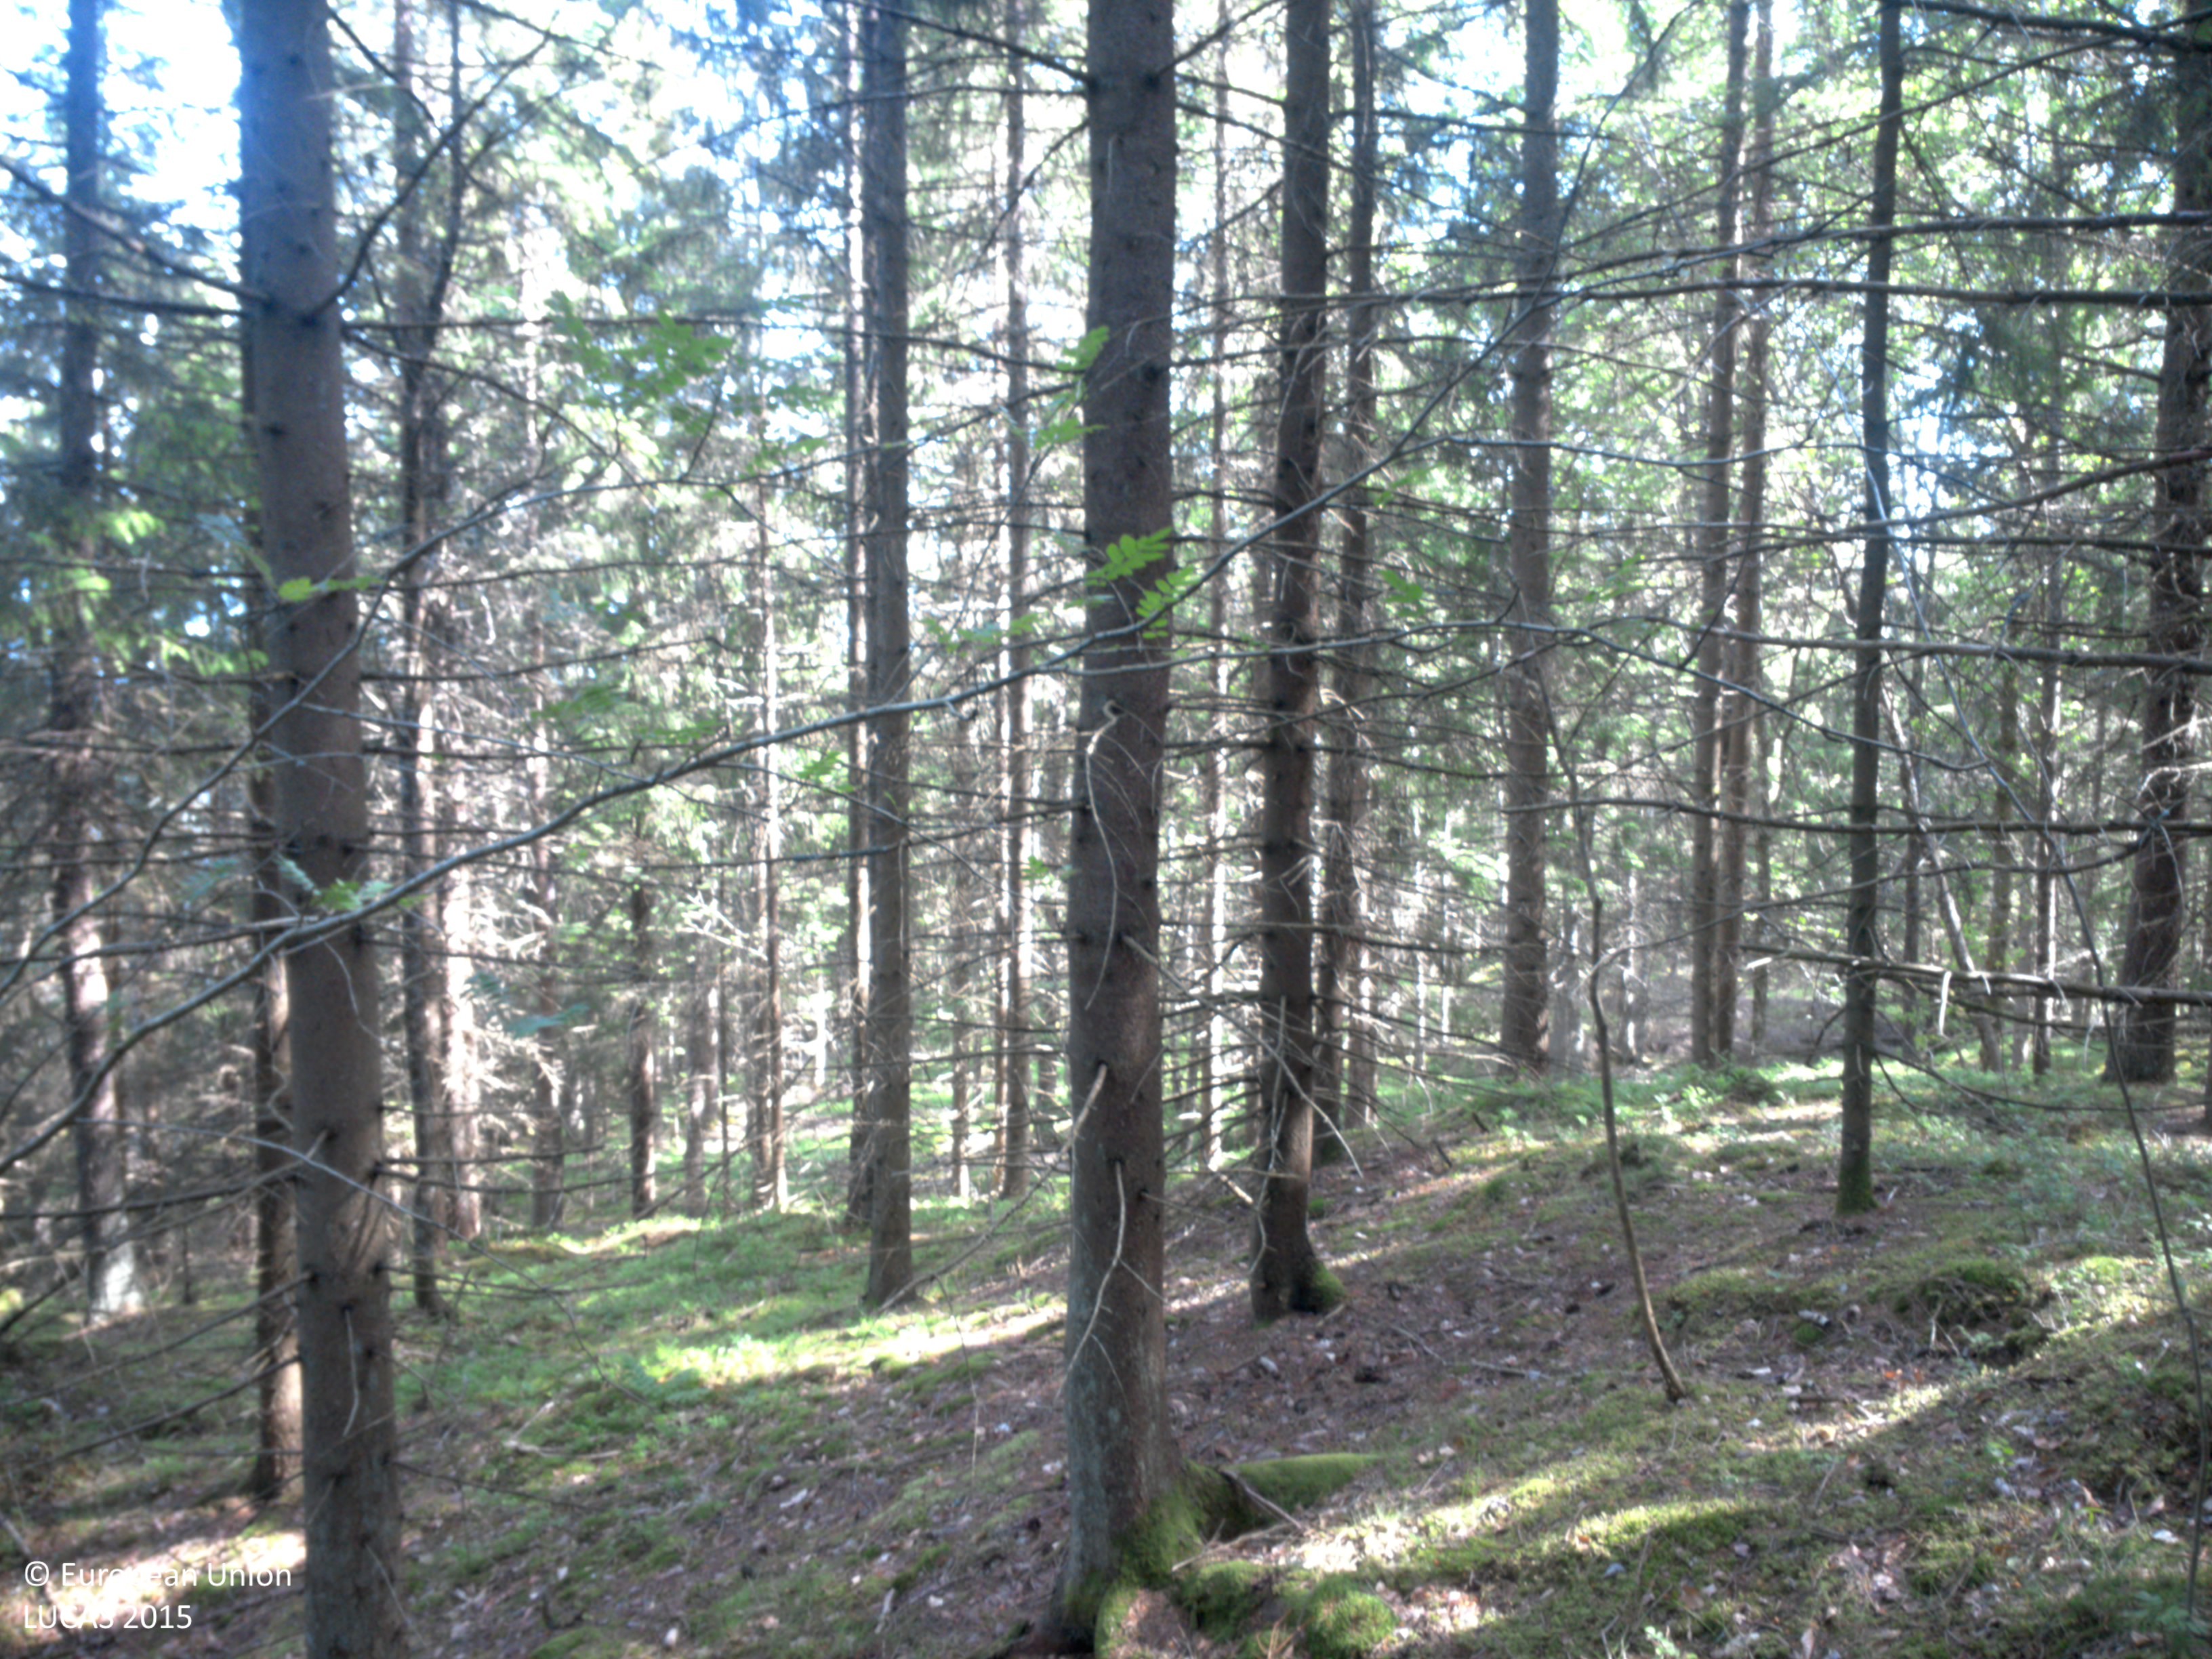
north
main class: Woodland
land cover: Spruce dominated mixed woodland
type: boreal forest
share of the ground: > 75 %
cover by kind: coniferous forest trees 55 %, broadleaved forest trees 25 %, lichens and mosses 20 %
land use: Forestry
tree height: > 5 m
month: June
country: SE
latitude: 58.4439
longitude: 11.5899
